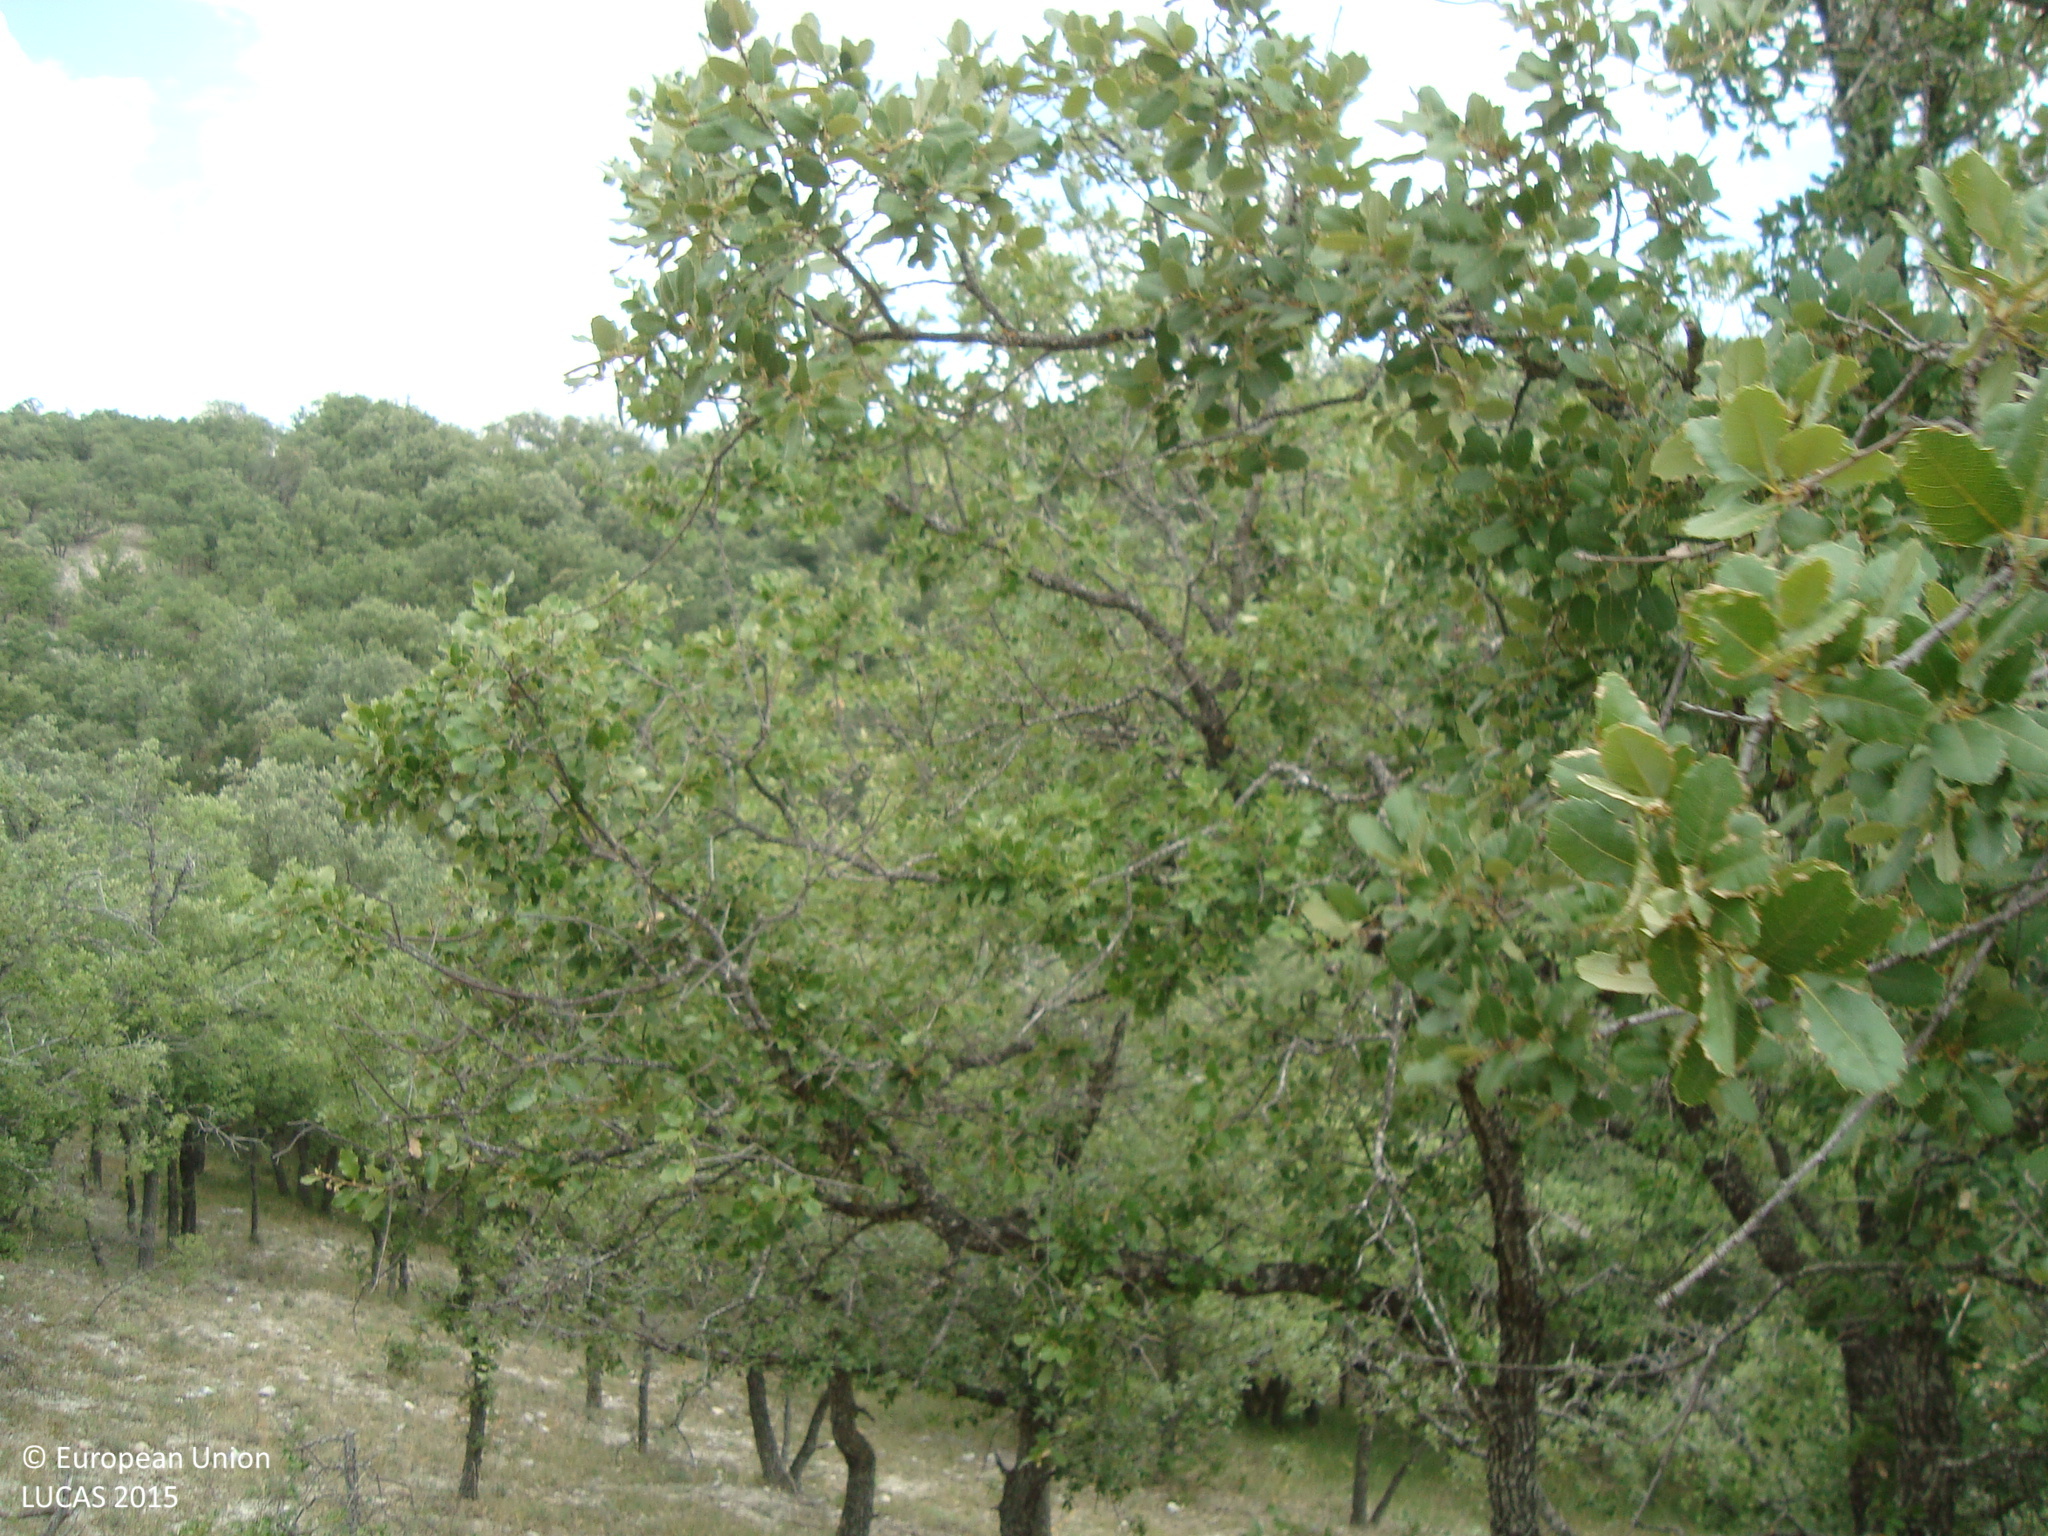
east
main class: Woodland
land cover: Broadleaved woodland
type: broadleaved evergreen forest
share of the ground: 50 - 75 %
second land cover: Spontaneously vegetated surfaces
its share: 25 - 50 %
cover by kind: broadleaved forest trees 60 %, herbaceous plants 25 %, unconsolidated bare surface 10 %, shrubs 5 %
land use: Forestry
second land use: Agriculture (excluding fallow land and kitchen gardens)
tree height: > 5 m
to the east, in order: Broadleaved woodland; Spontaneously vegetated surfaces; Tracks; Broadleaved woodland
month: July
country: ES
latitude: 41.9492
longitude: -4.1407
